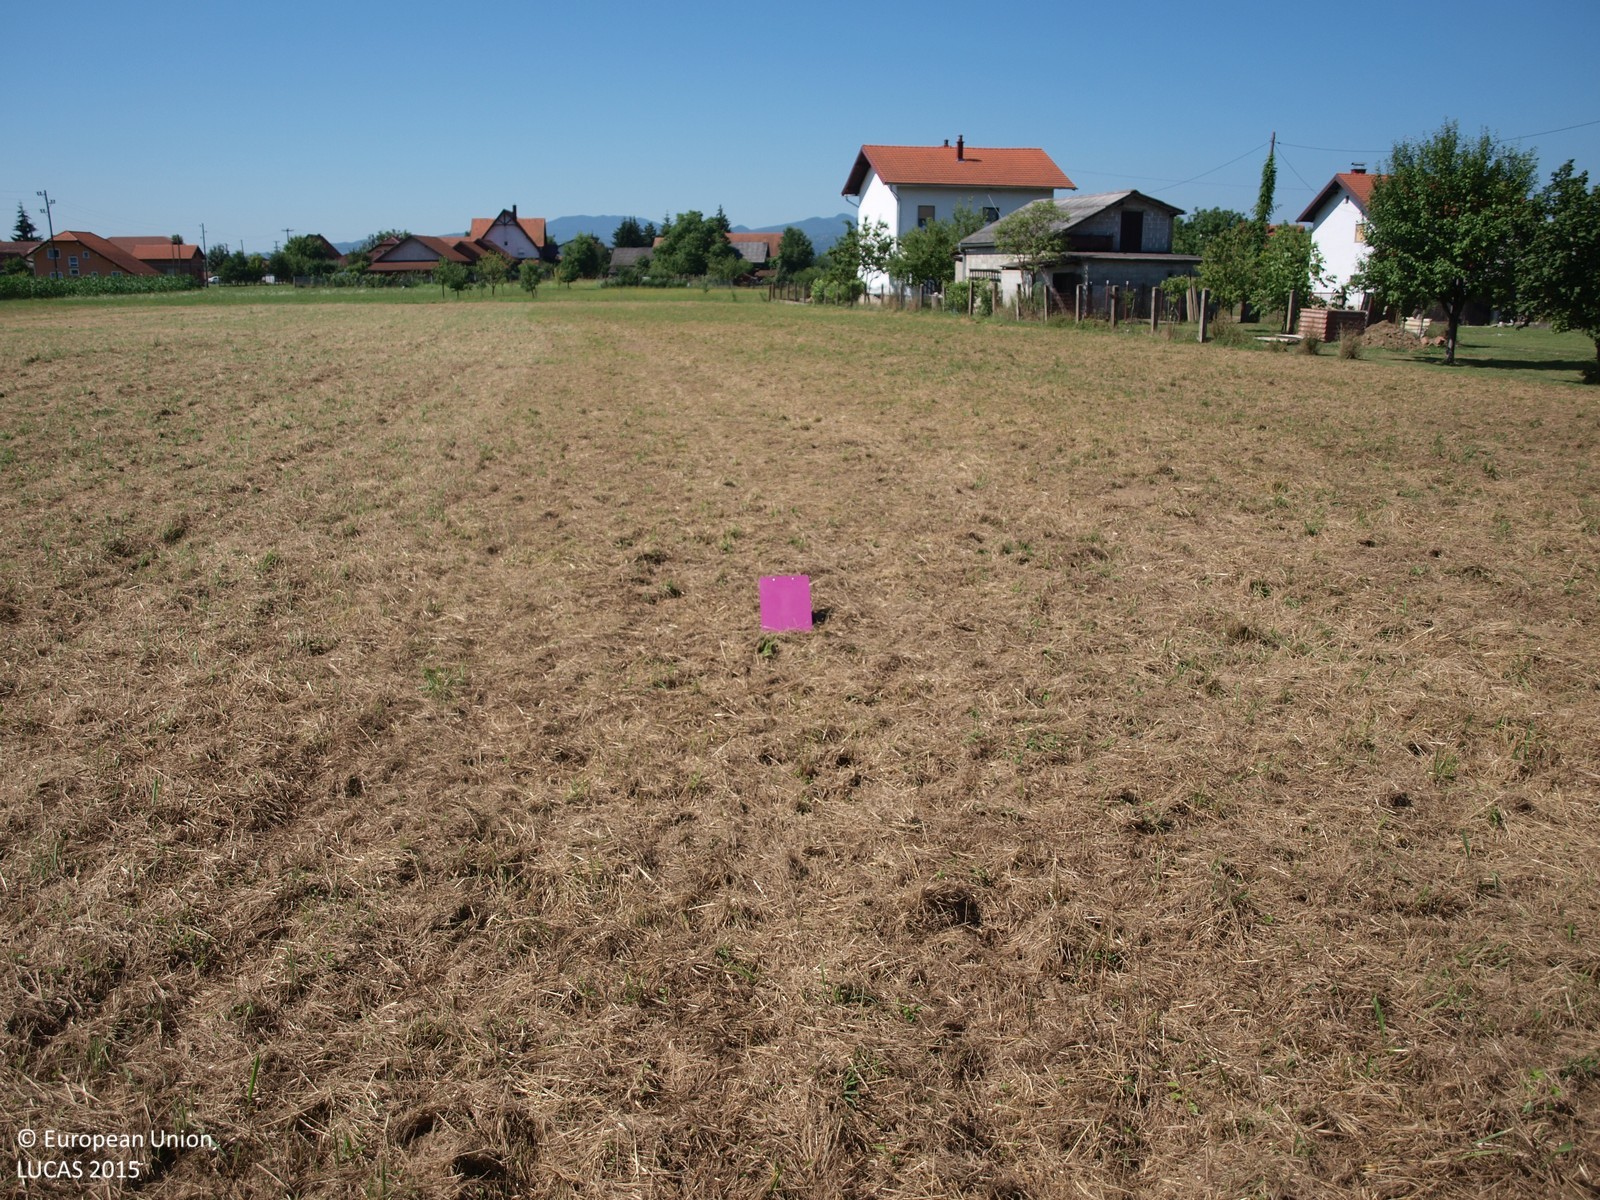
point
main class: Grassland
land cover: Grassland without tree/shrub cover
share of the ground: > 75 %
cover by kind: herbaceous plants 100 %
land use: Agriculture (excluding fallow land and kitchen gardens)
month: July
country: HR
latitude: 45.8712
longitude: 15.7561
